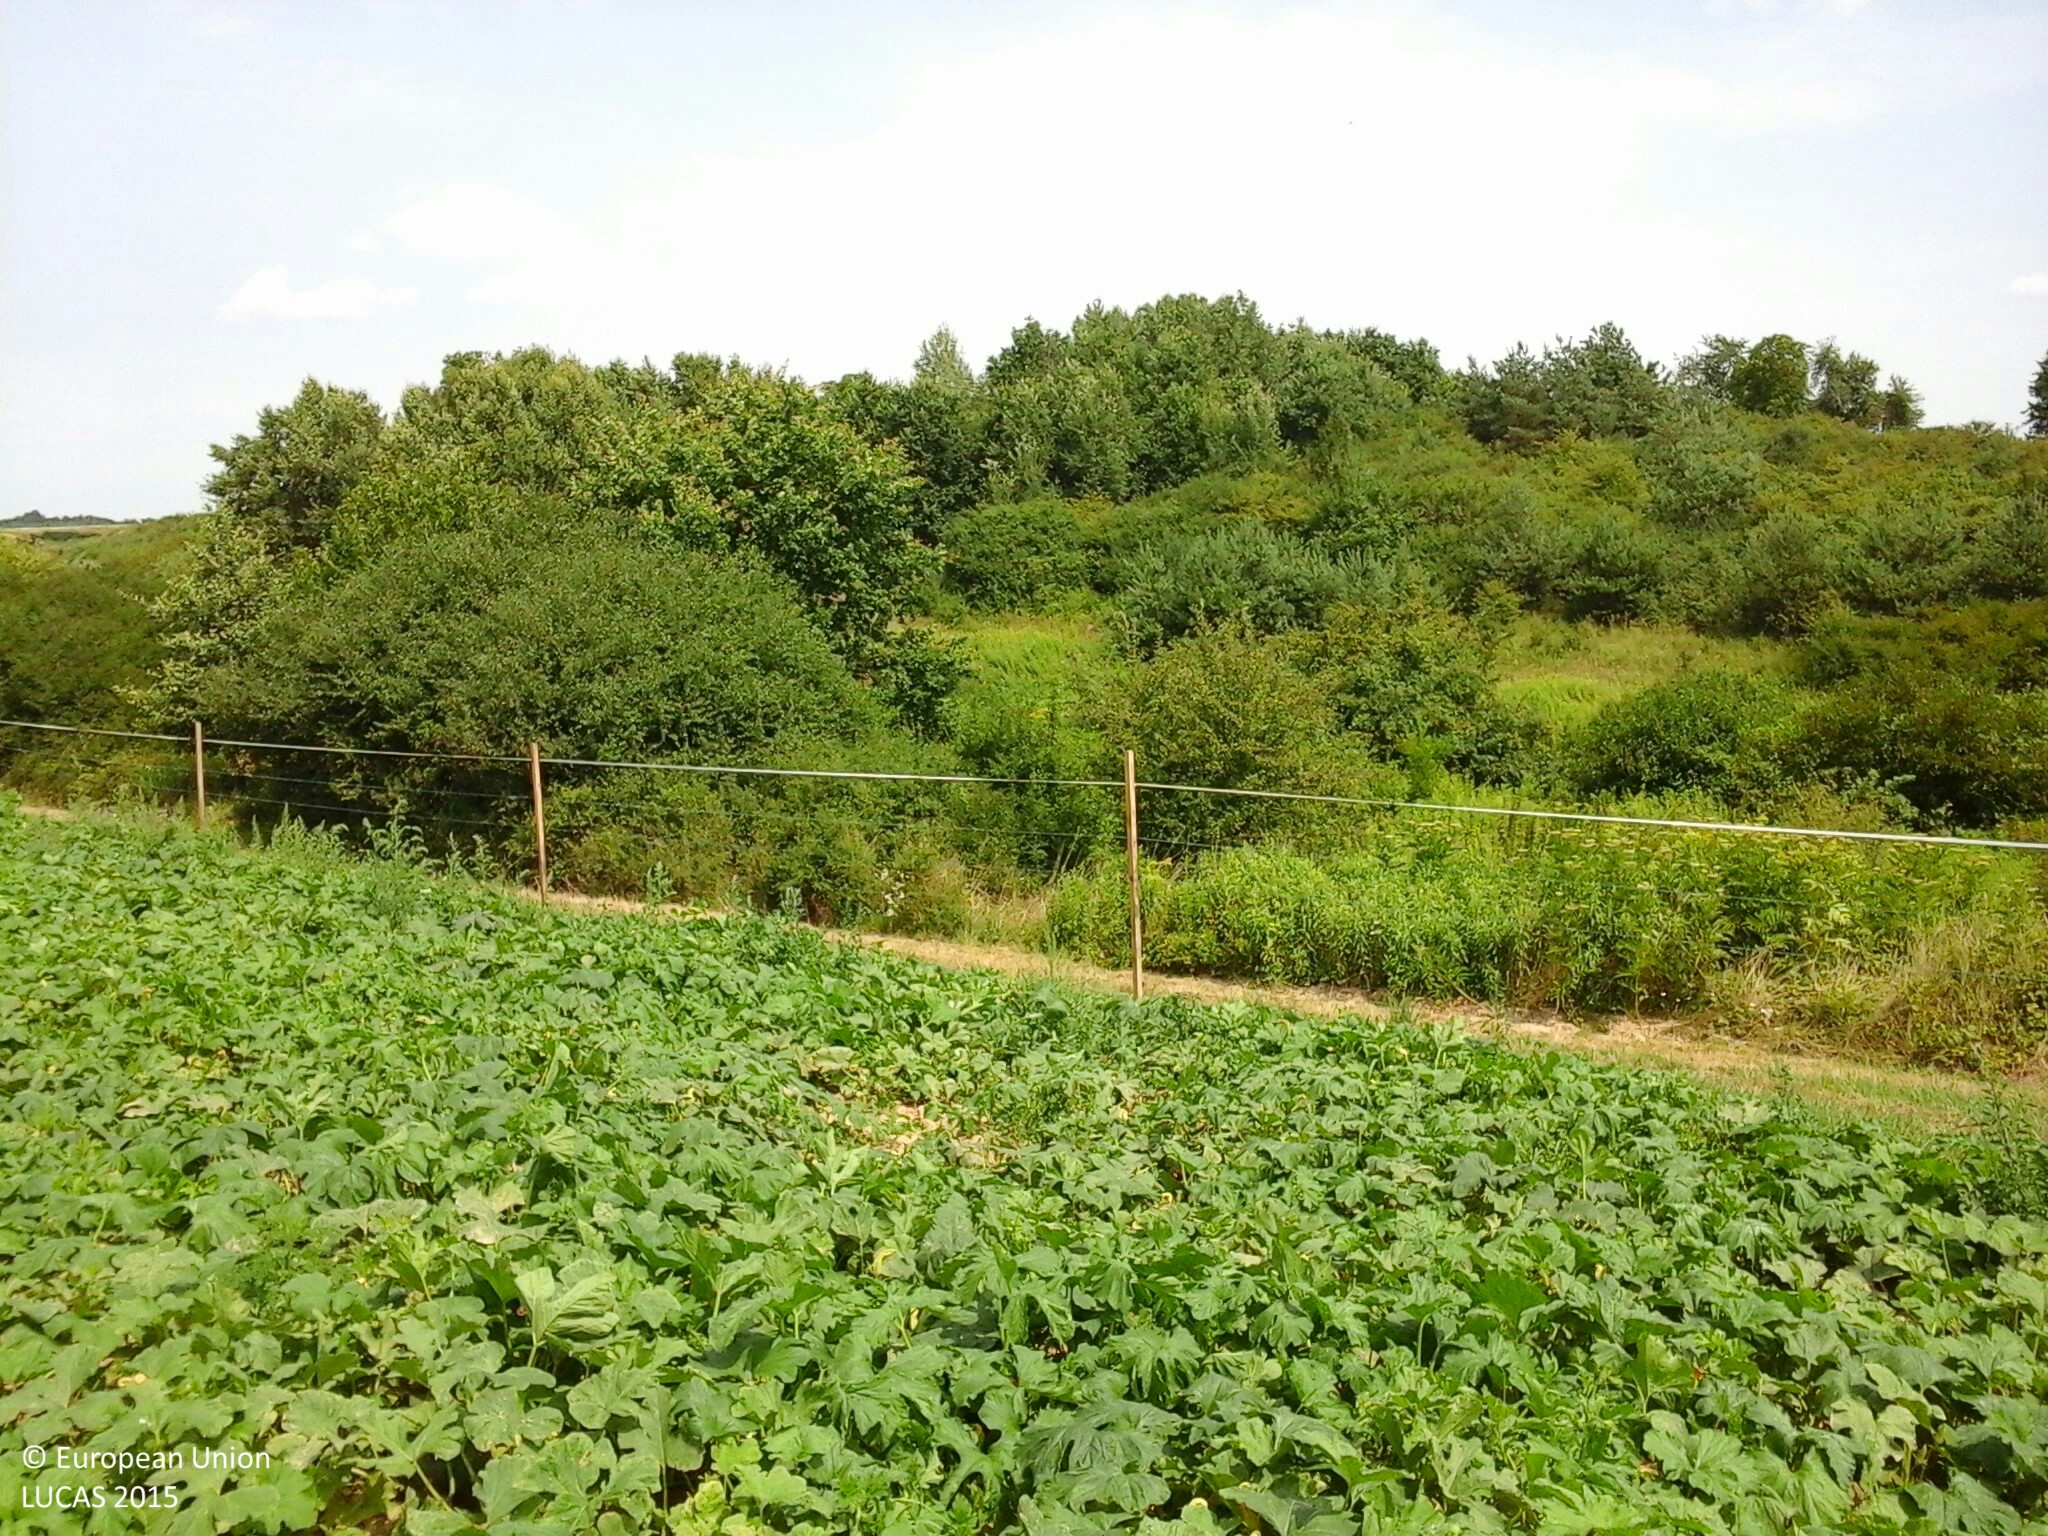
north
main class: Cropland
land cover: Other fresh vegetables
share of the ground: > 75 %
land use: Agriculture (excluding fallow land and kitchen gardens)
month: July
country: HU
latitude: 46.9004
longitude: 16.3947
